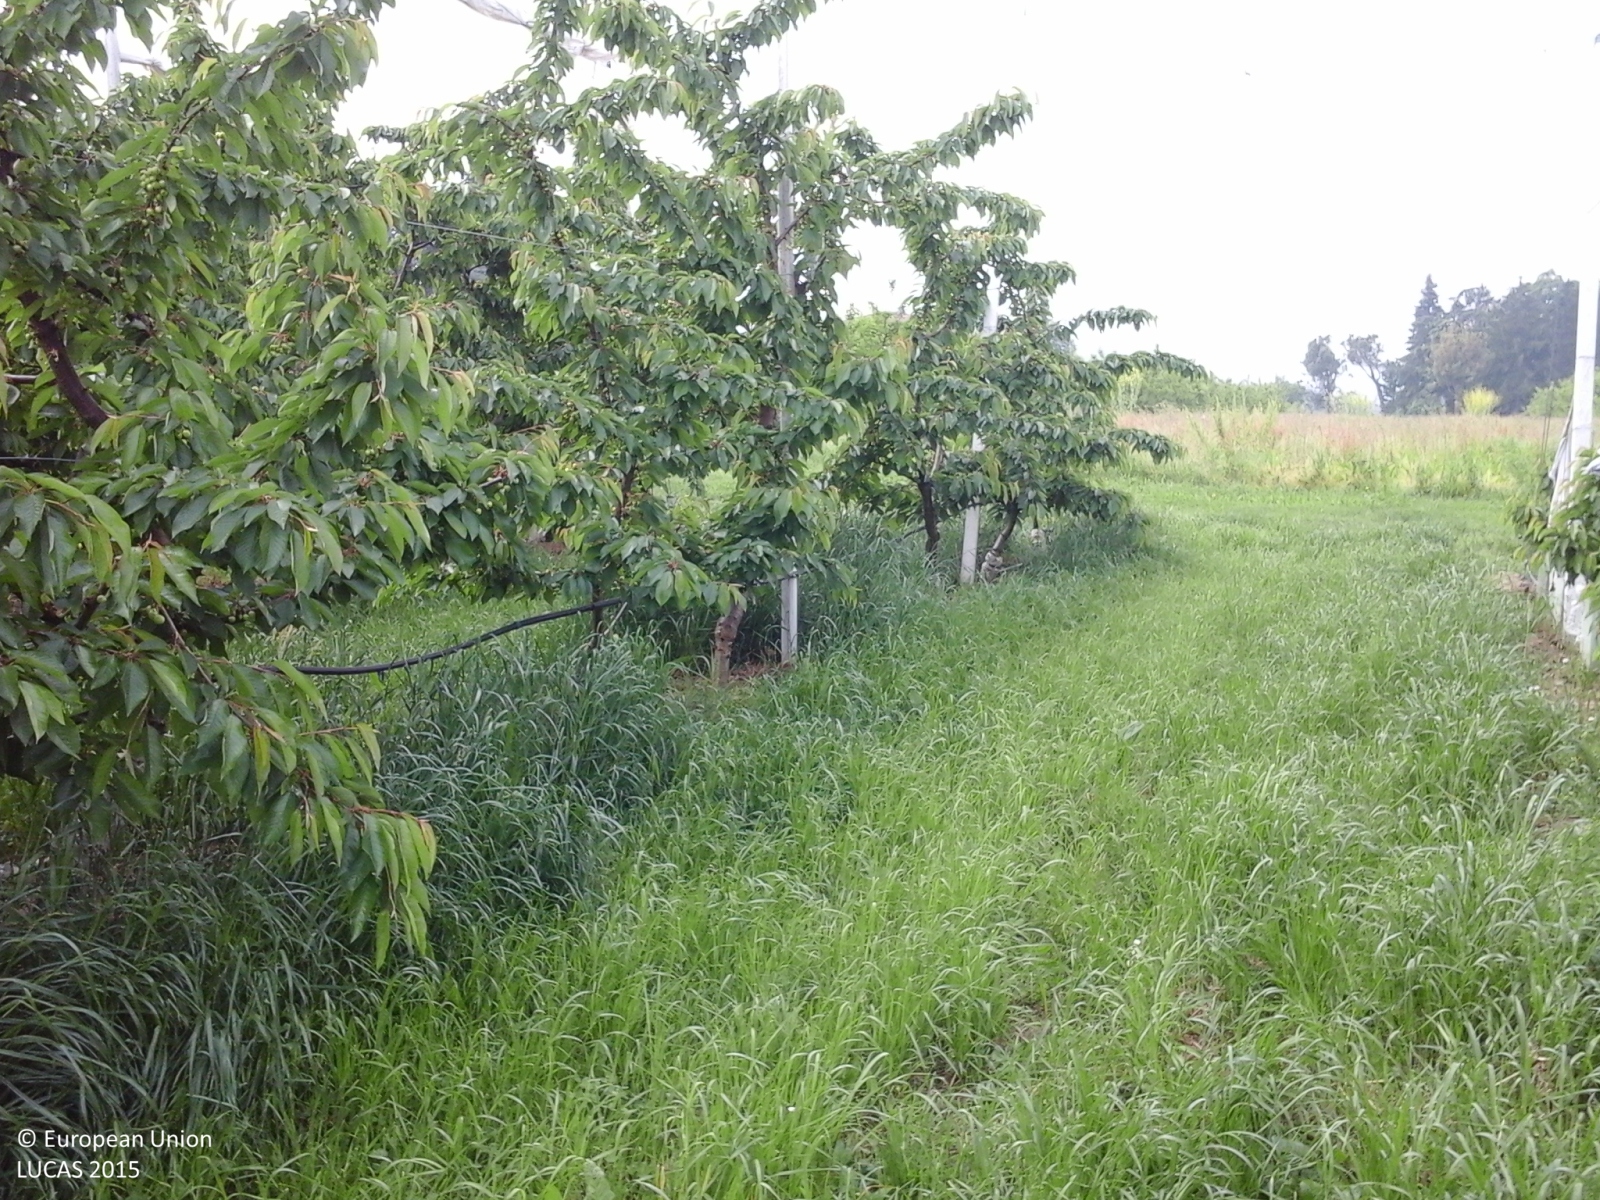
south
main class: Cropland
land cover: Cherry fruit
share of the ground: 50 - 75 %
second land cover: Grassland without tree/shrub cover
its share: > 75 %
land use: Agriculture (excluding fallow land and kitchen gardens)
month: May
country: IT
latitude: 44.4896
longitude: 11.0414
